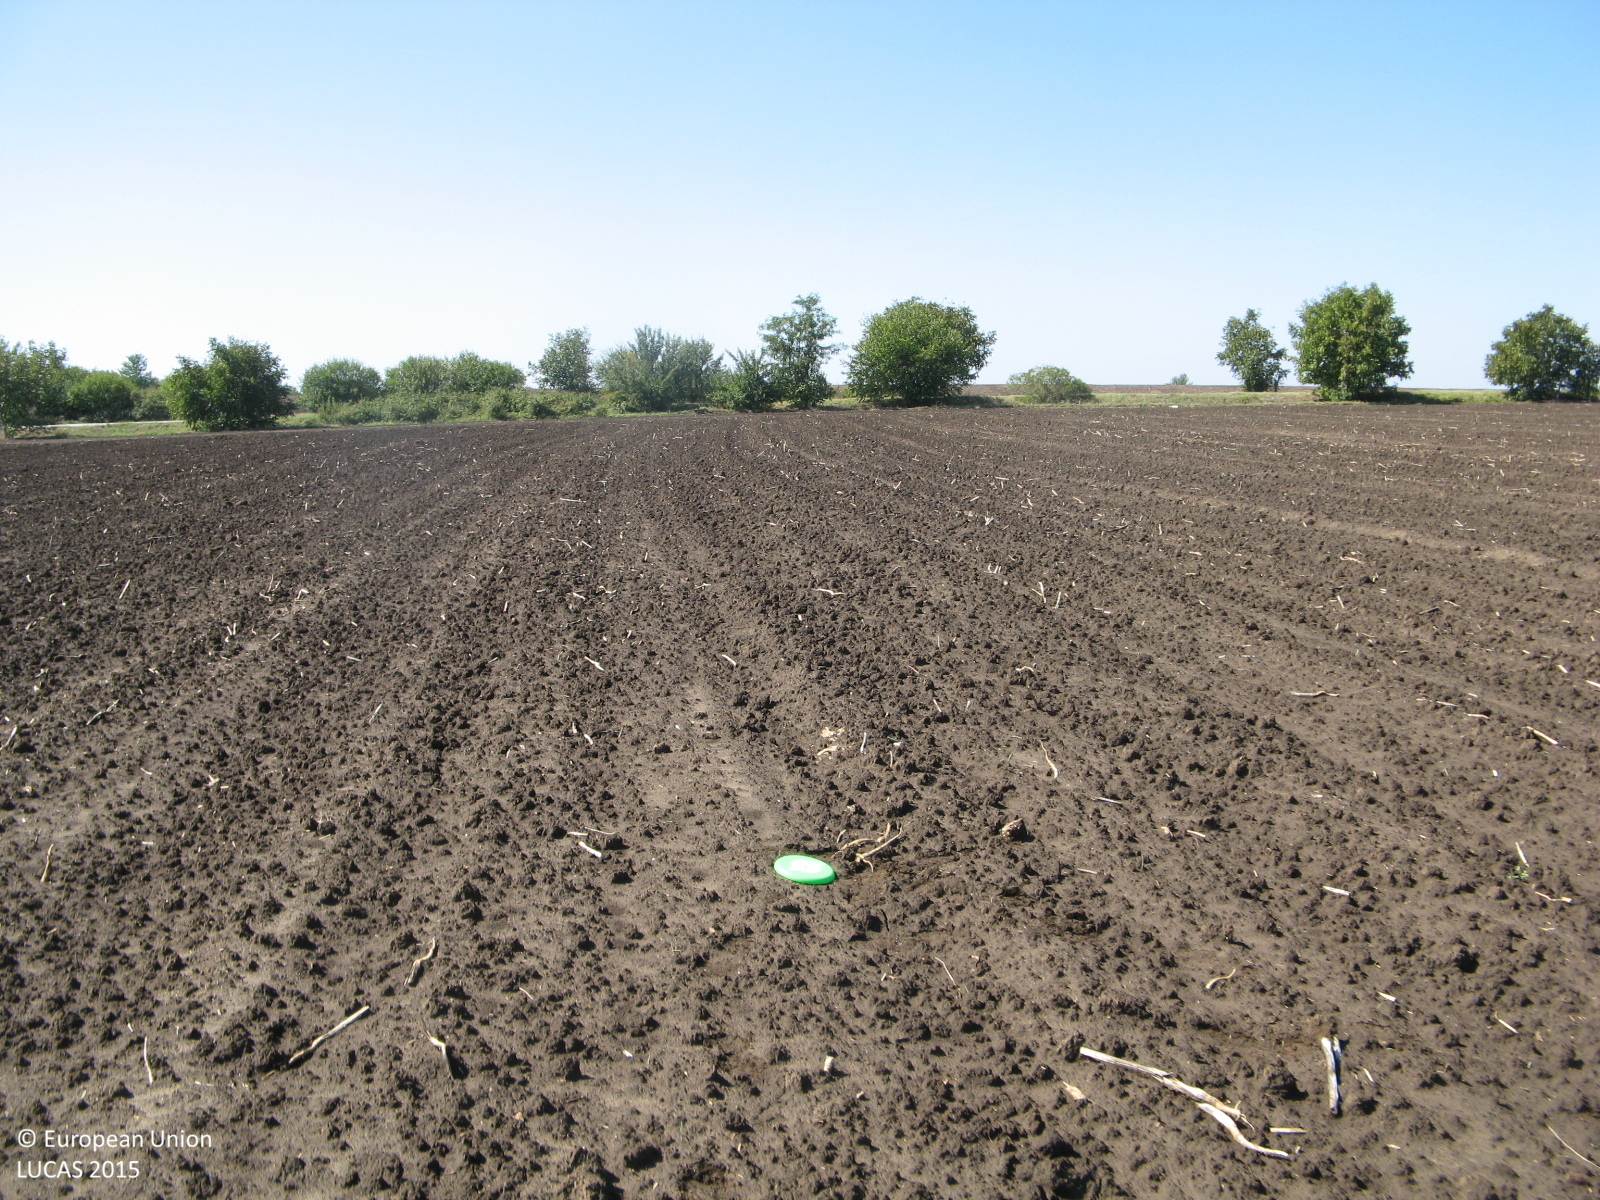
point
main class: Cropland
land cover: Rape and turnip rape
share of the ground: < 10 %
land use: Agriculture (excluding fallow land and kitchen gardens)
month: September
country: BG
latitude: 43.4899
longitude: 25.3748
